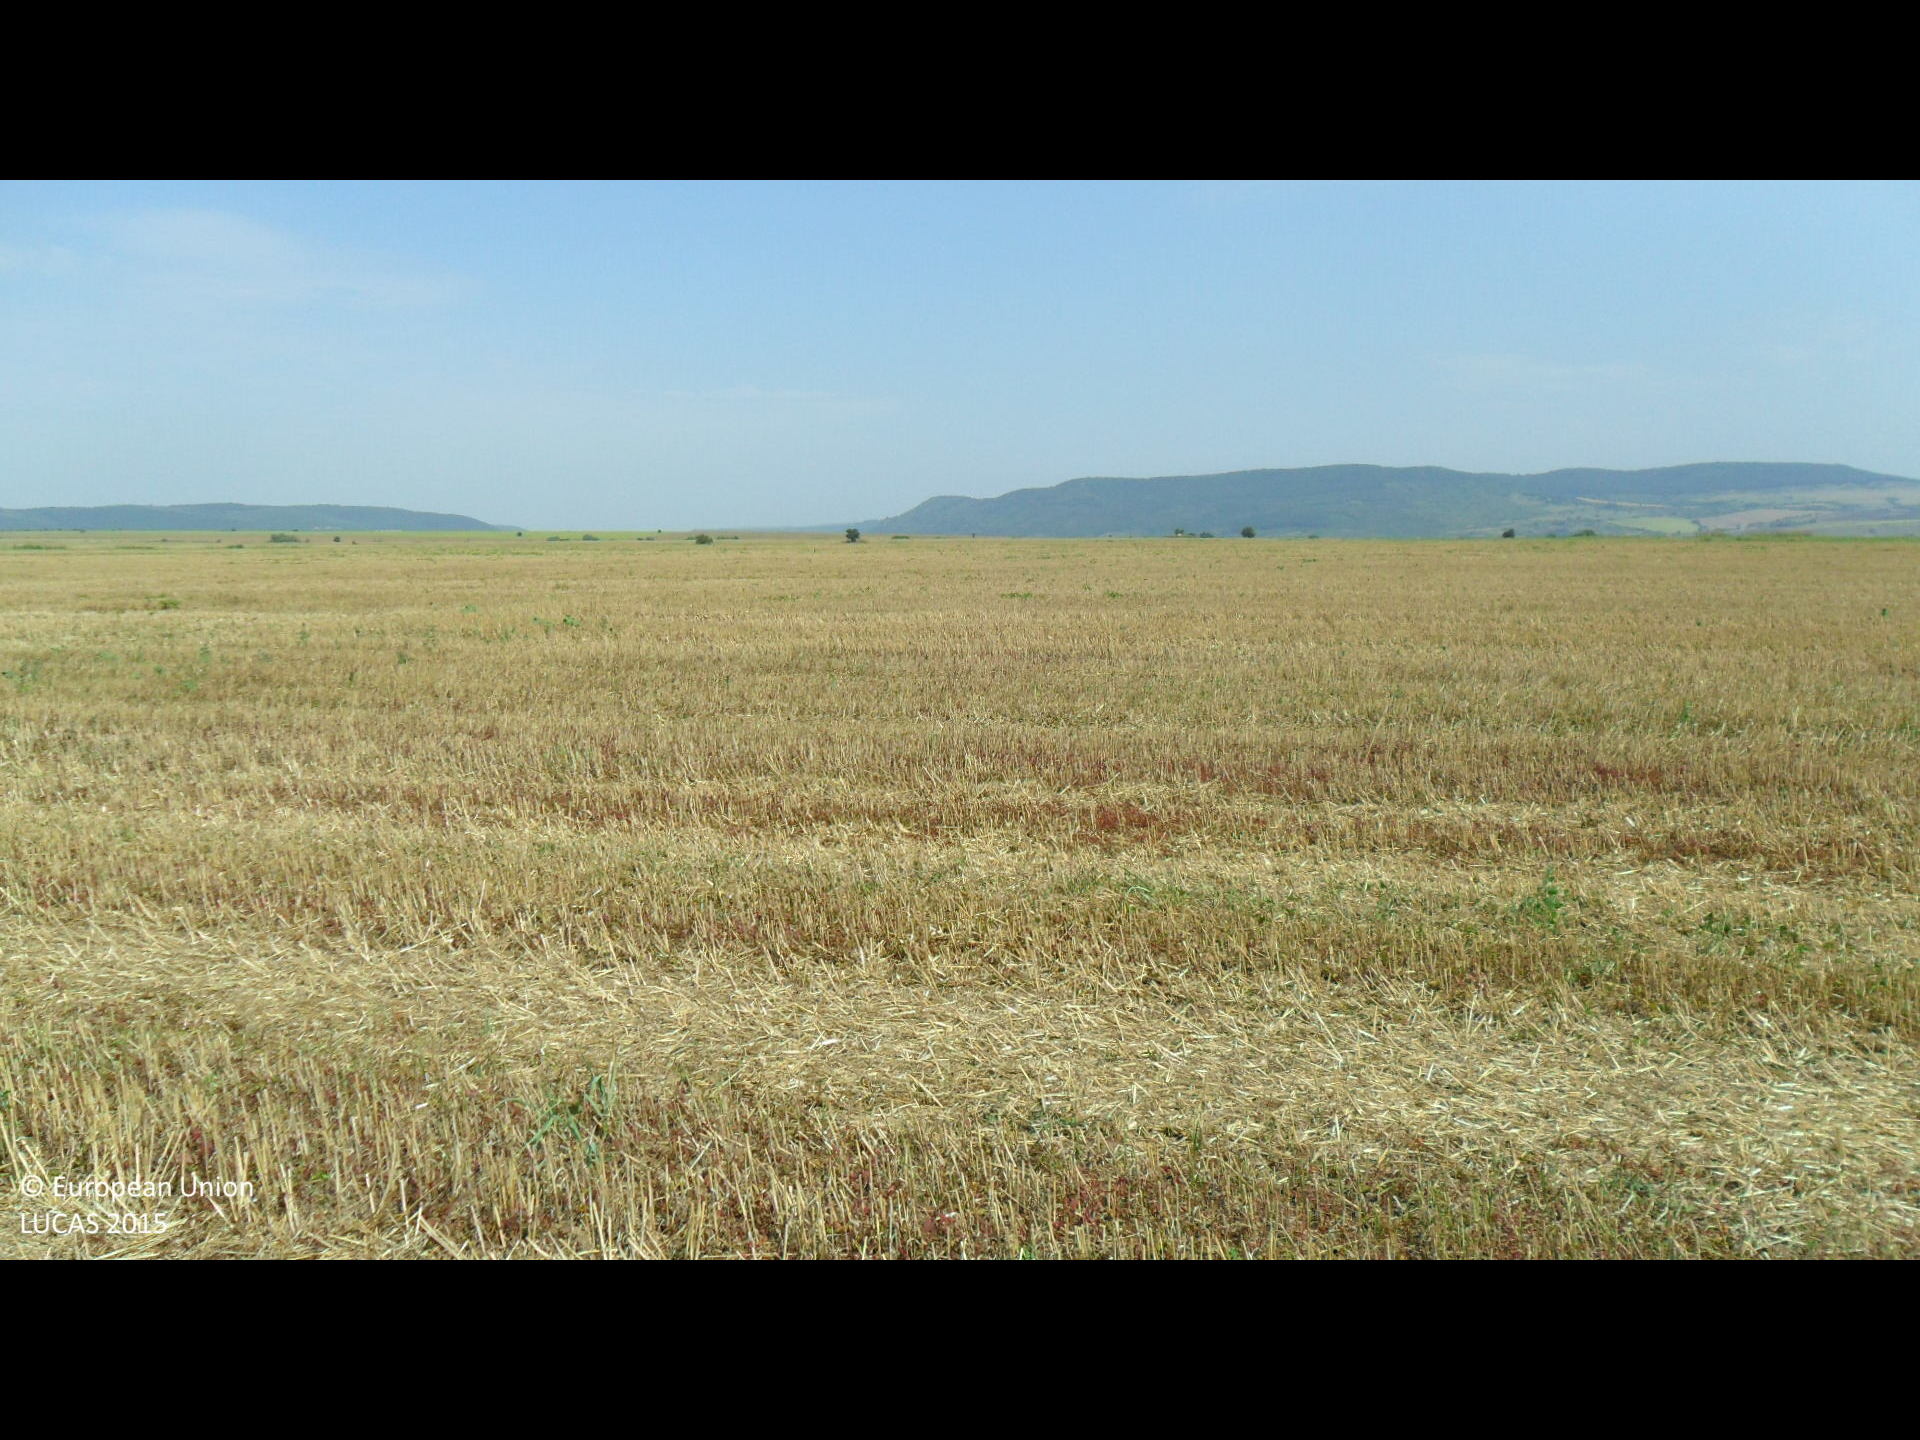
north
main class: Cropland
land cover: Barley
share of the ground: > 75 %
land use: Agriculture (excluding fallow land and kitchen gardens)
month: August
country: BG
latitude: 43.3752
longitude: 26.2277
